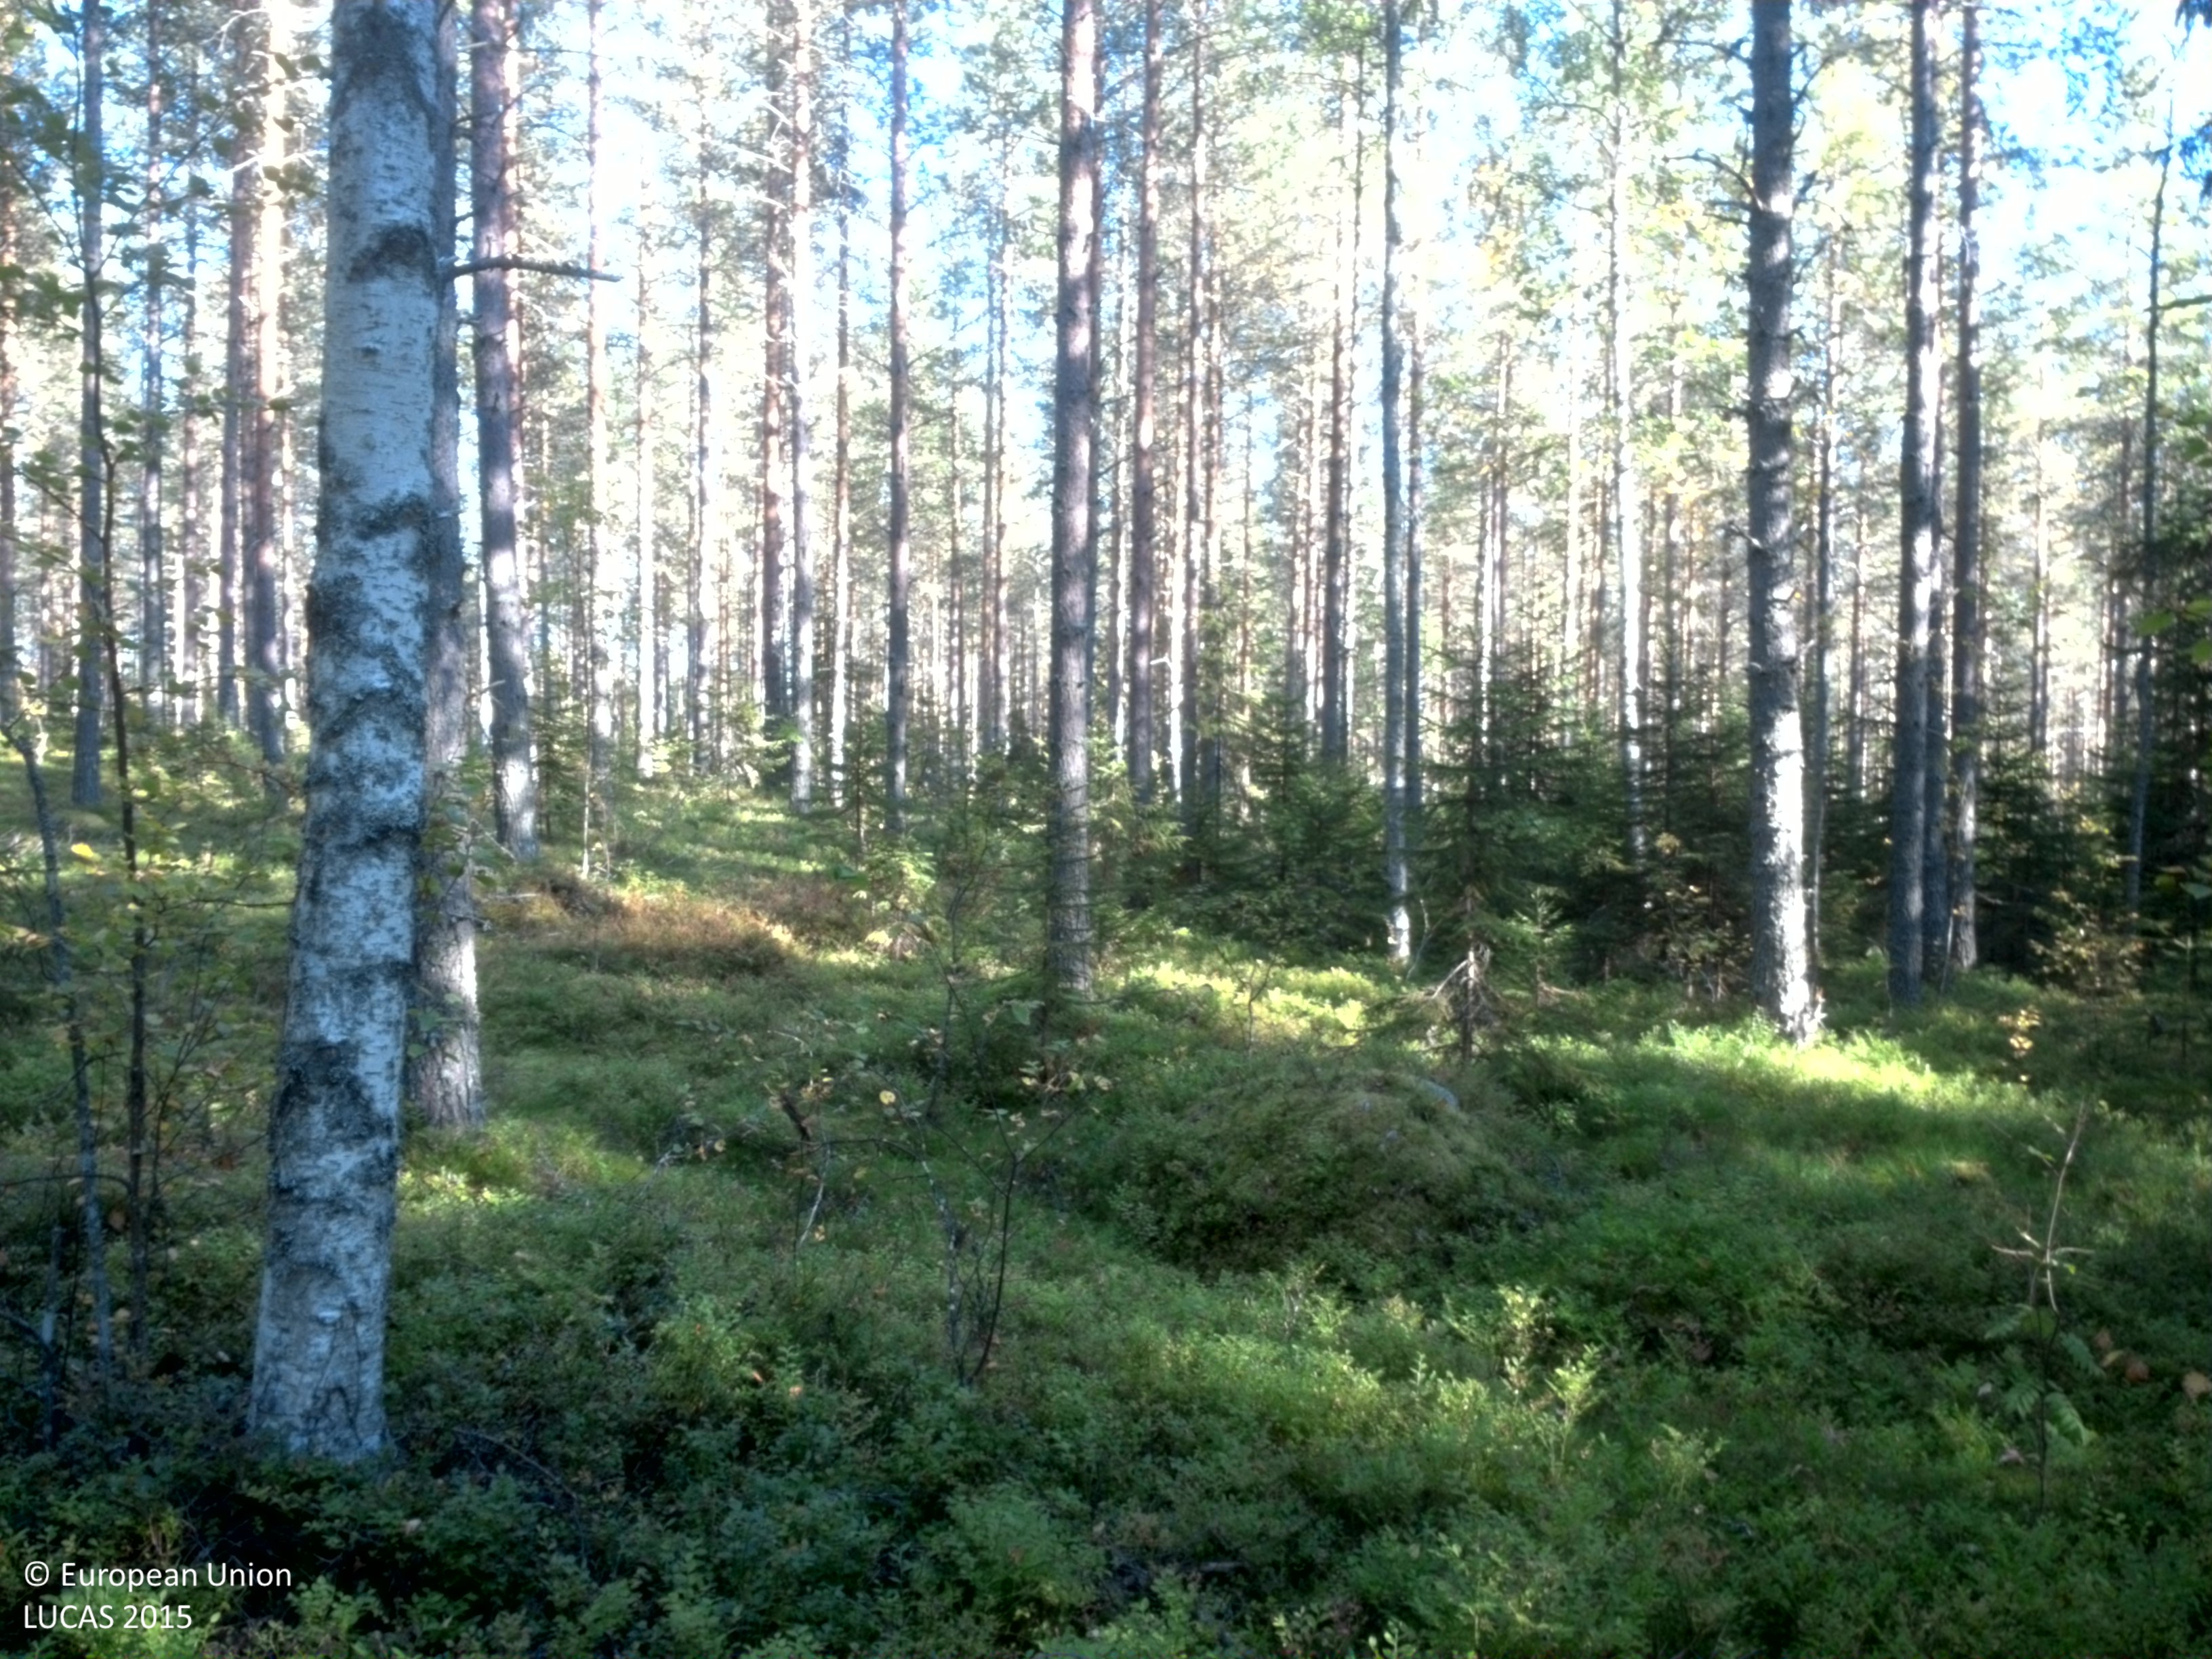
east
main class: Woodland
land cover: Other mixed woodland
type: boreal forest
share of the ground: 50 - 75 %
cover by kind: coniferous forest trees 40 %, shrubs 40 %, broadleaved forest trees 20 %
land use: Forestry
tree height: > 5 m
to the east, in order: Other mixed woodland; Pine dominated coniferous woodland; Other mixed woodland; Pine dominated mixed woodland; Pine dominated coniferous woodland; Pine dominated mixed woodland; Ditches and canals; Broadleaved woodland; Tracks
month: September
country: SE
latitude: 64.3184
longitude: 19.7152
